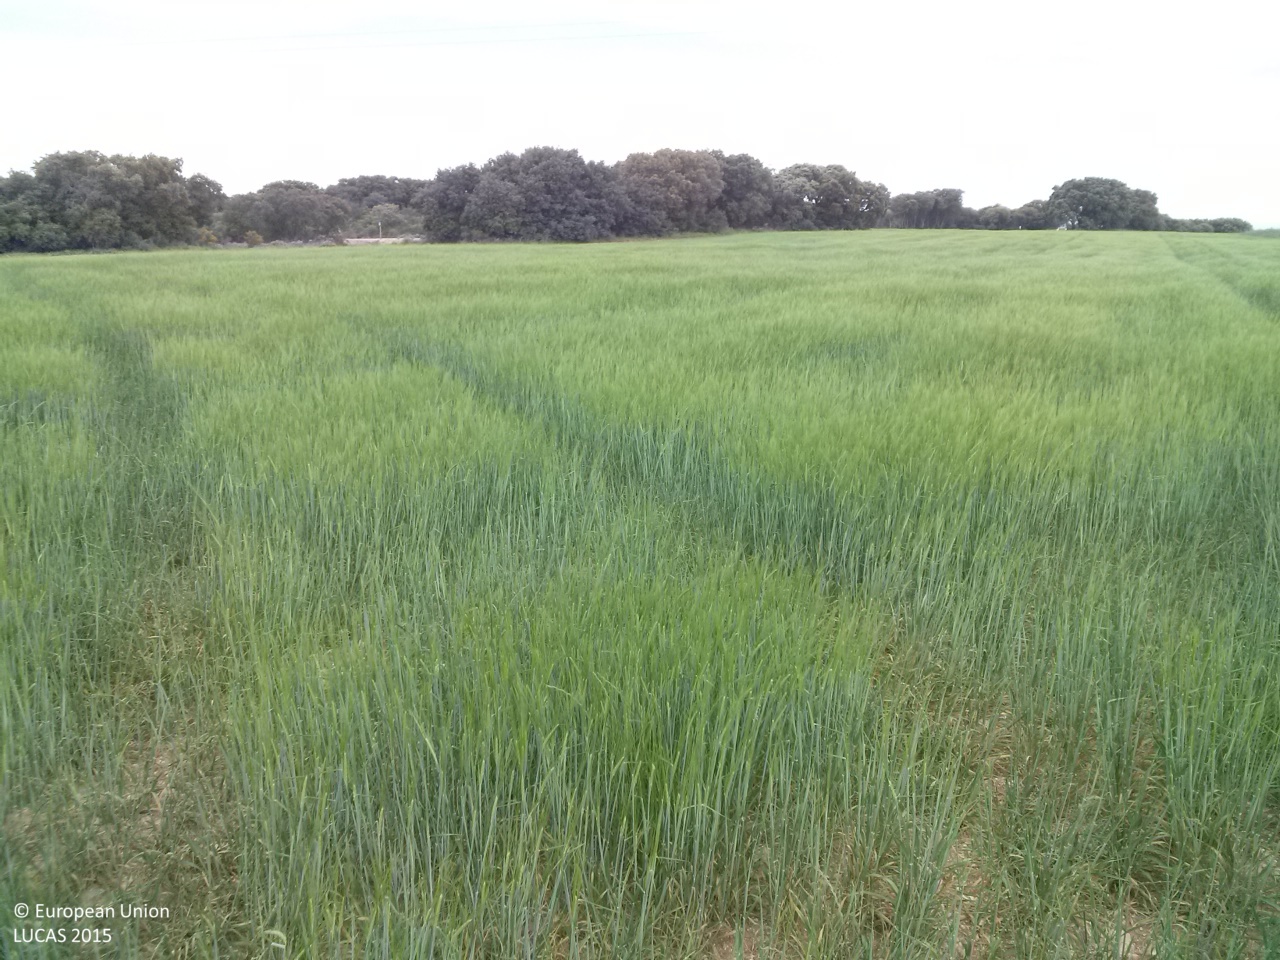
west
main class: Cropland
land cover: Barley
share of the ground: > 75 %
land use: Agriculture (excluding fallow land and kitchen gardens)
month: May
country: ES
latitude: 39.8763
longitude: -2.8467
